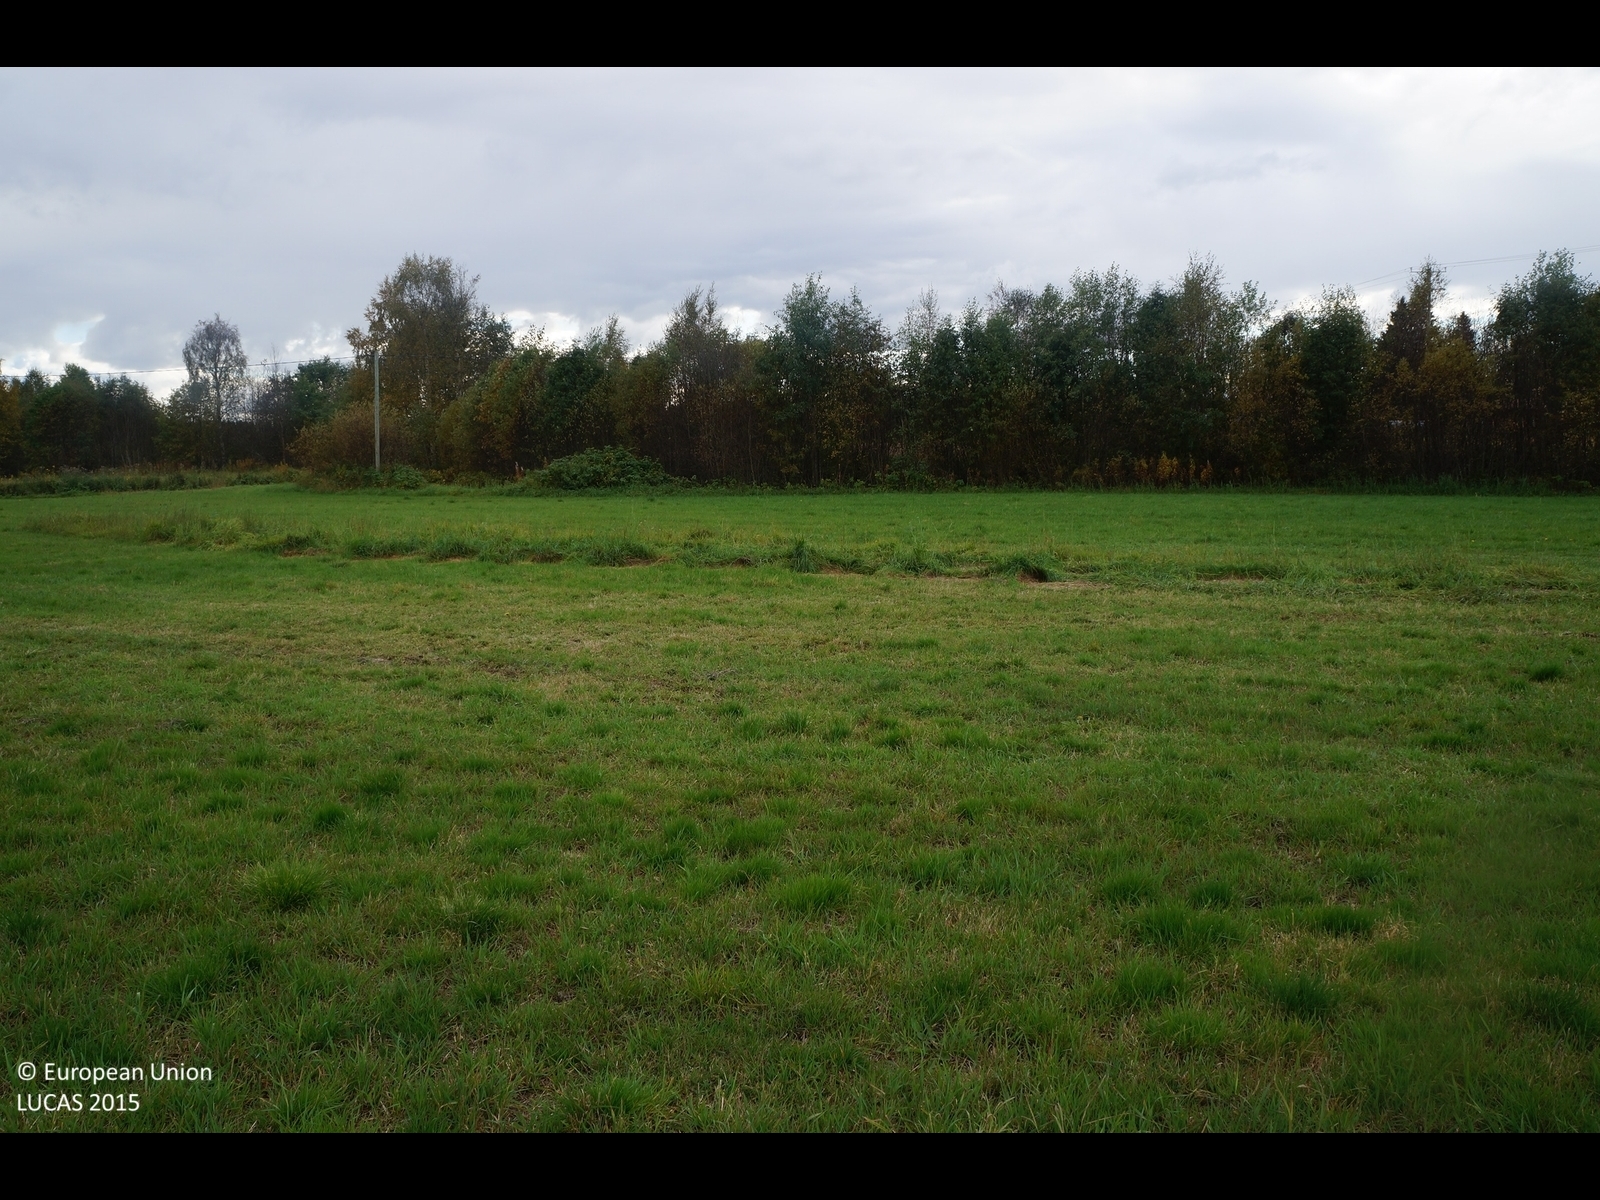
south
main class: Cropland
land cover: Temporary grasslands
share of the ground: > 75 %
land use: Agriculture (excluding fallow land and kitchen gardens)
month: September
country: FI
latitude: 64.4073
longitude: 24.3209
